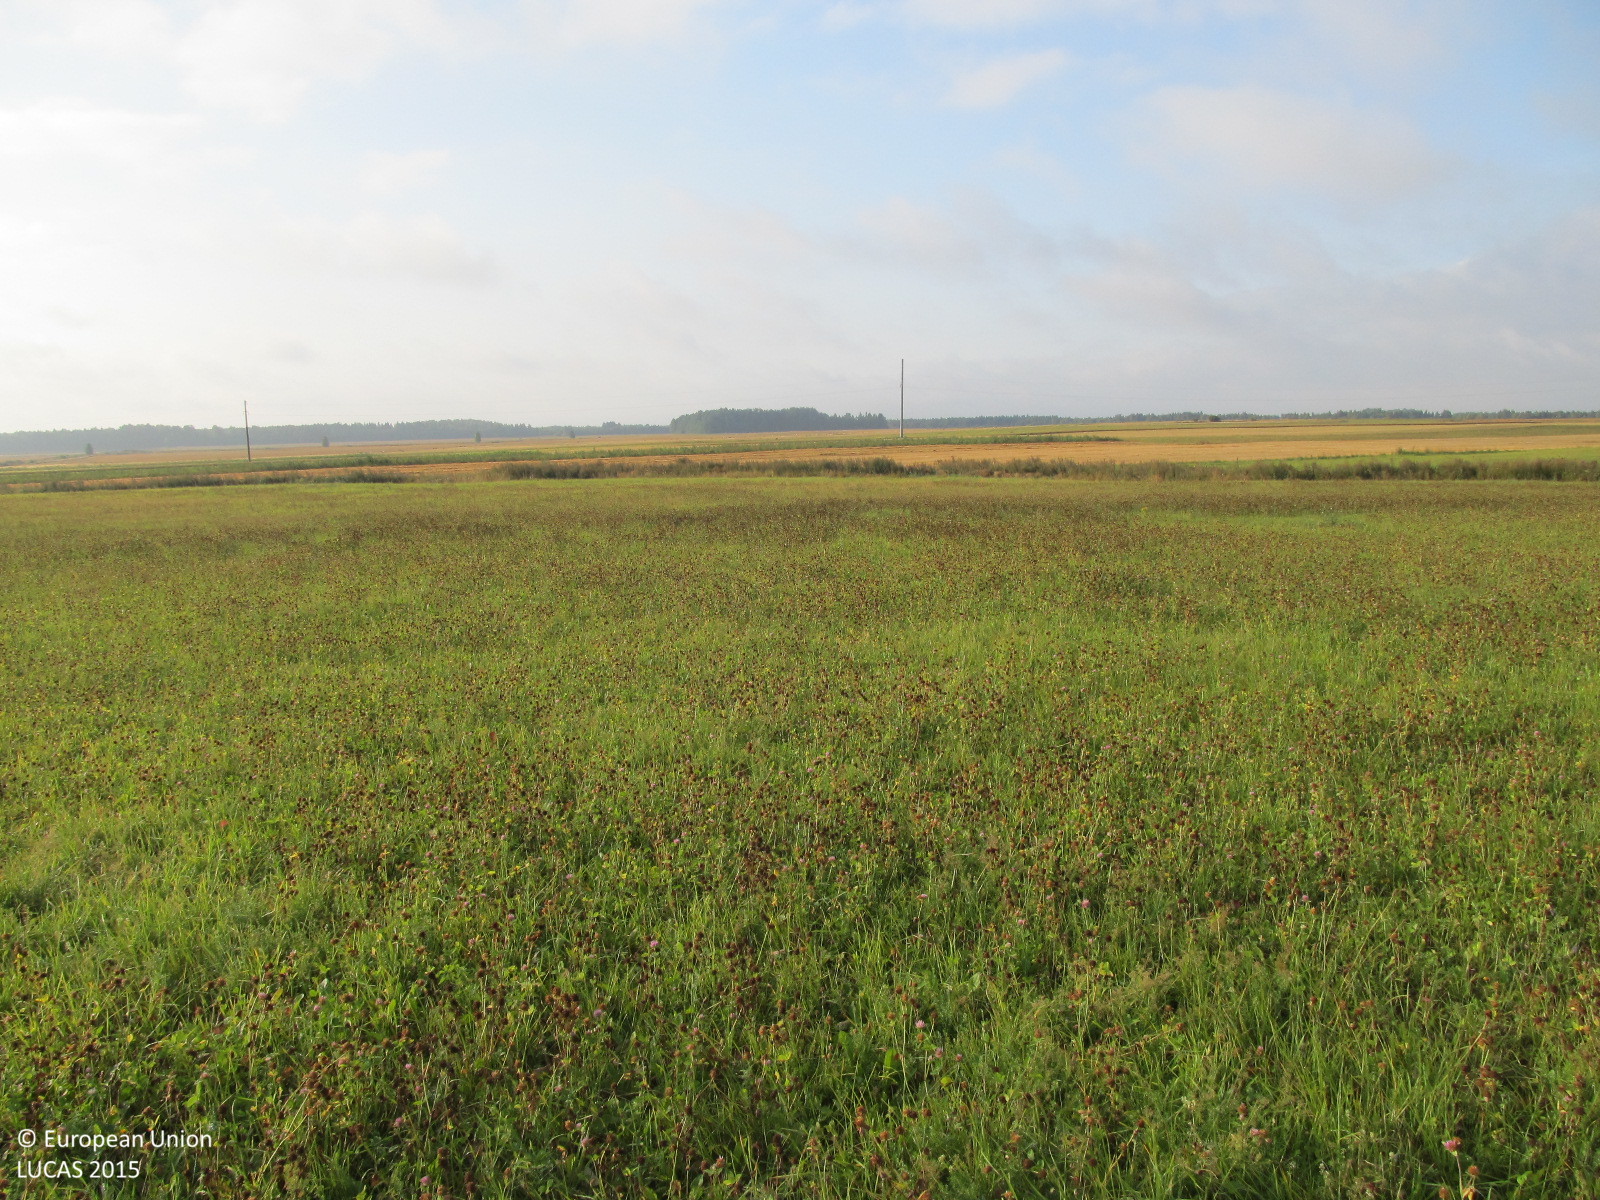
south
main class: Cropland
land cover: Clovers
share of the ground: > 75 %
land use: Agriculture (excluding fallow land and kitchen gardens)
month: August
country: LT
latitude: 55.6574
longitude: 23.2824
